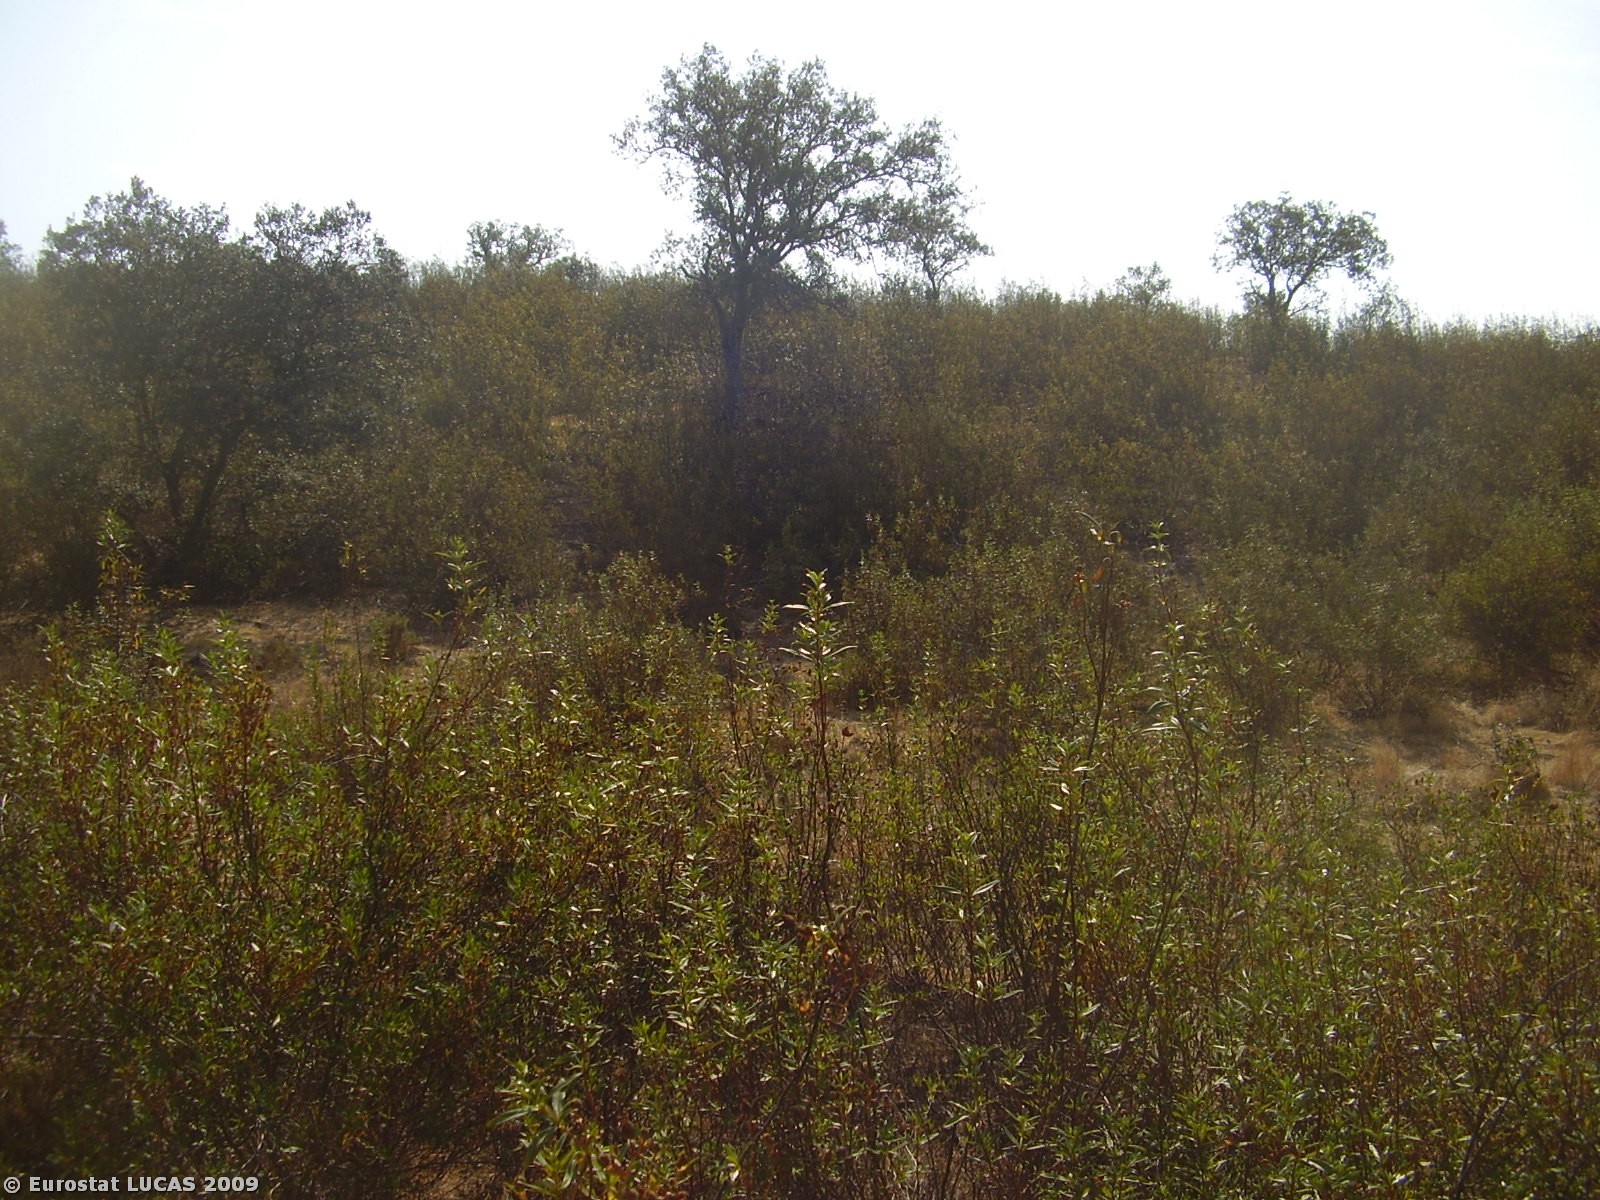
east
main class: Shrubland
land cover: Shrubland with sparse tree cover
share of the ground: 50 - 75 %
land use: Forestry
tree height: > 5 m
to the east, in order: Shrubland with sparse tree cover; Broadleaved woodland; Shrubland with sparse tree cover; Broadleaved woodland; Rivers and streams; Broadleaved woodland; Fences; Broadleaved woodland; Fences; Broadleaved woodland
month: August
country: PT
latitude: 37.5598
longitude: -8.2422
